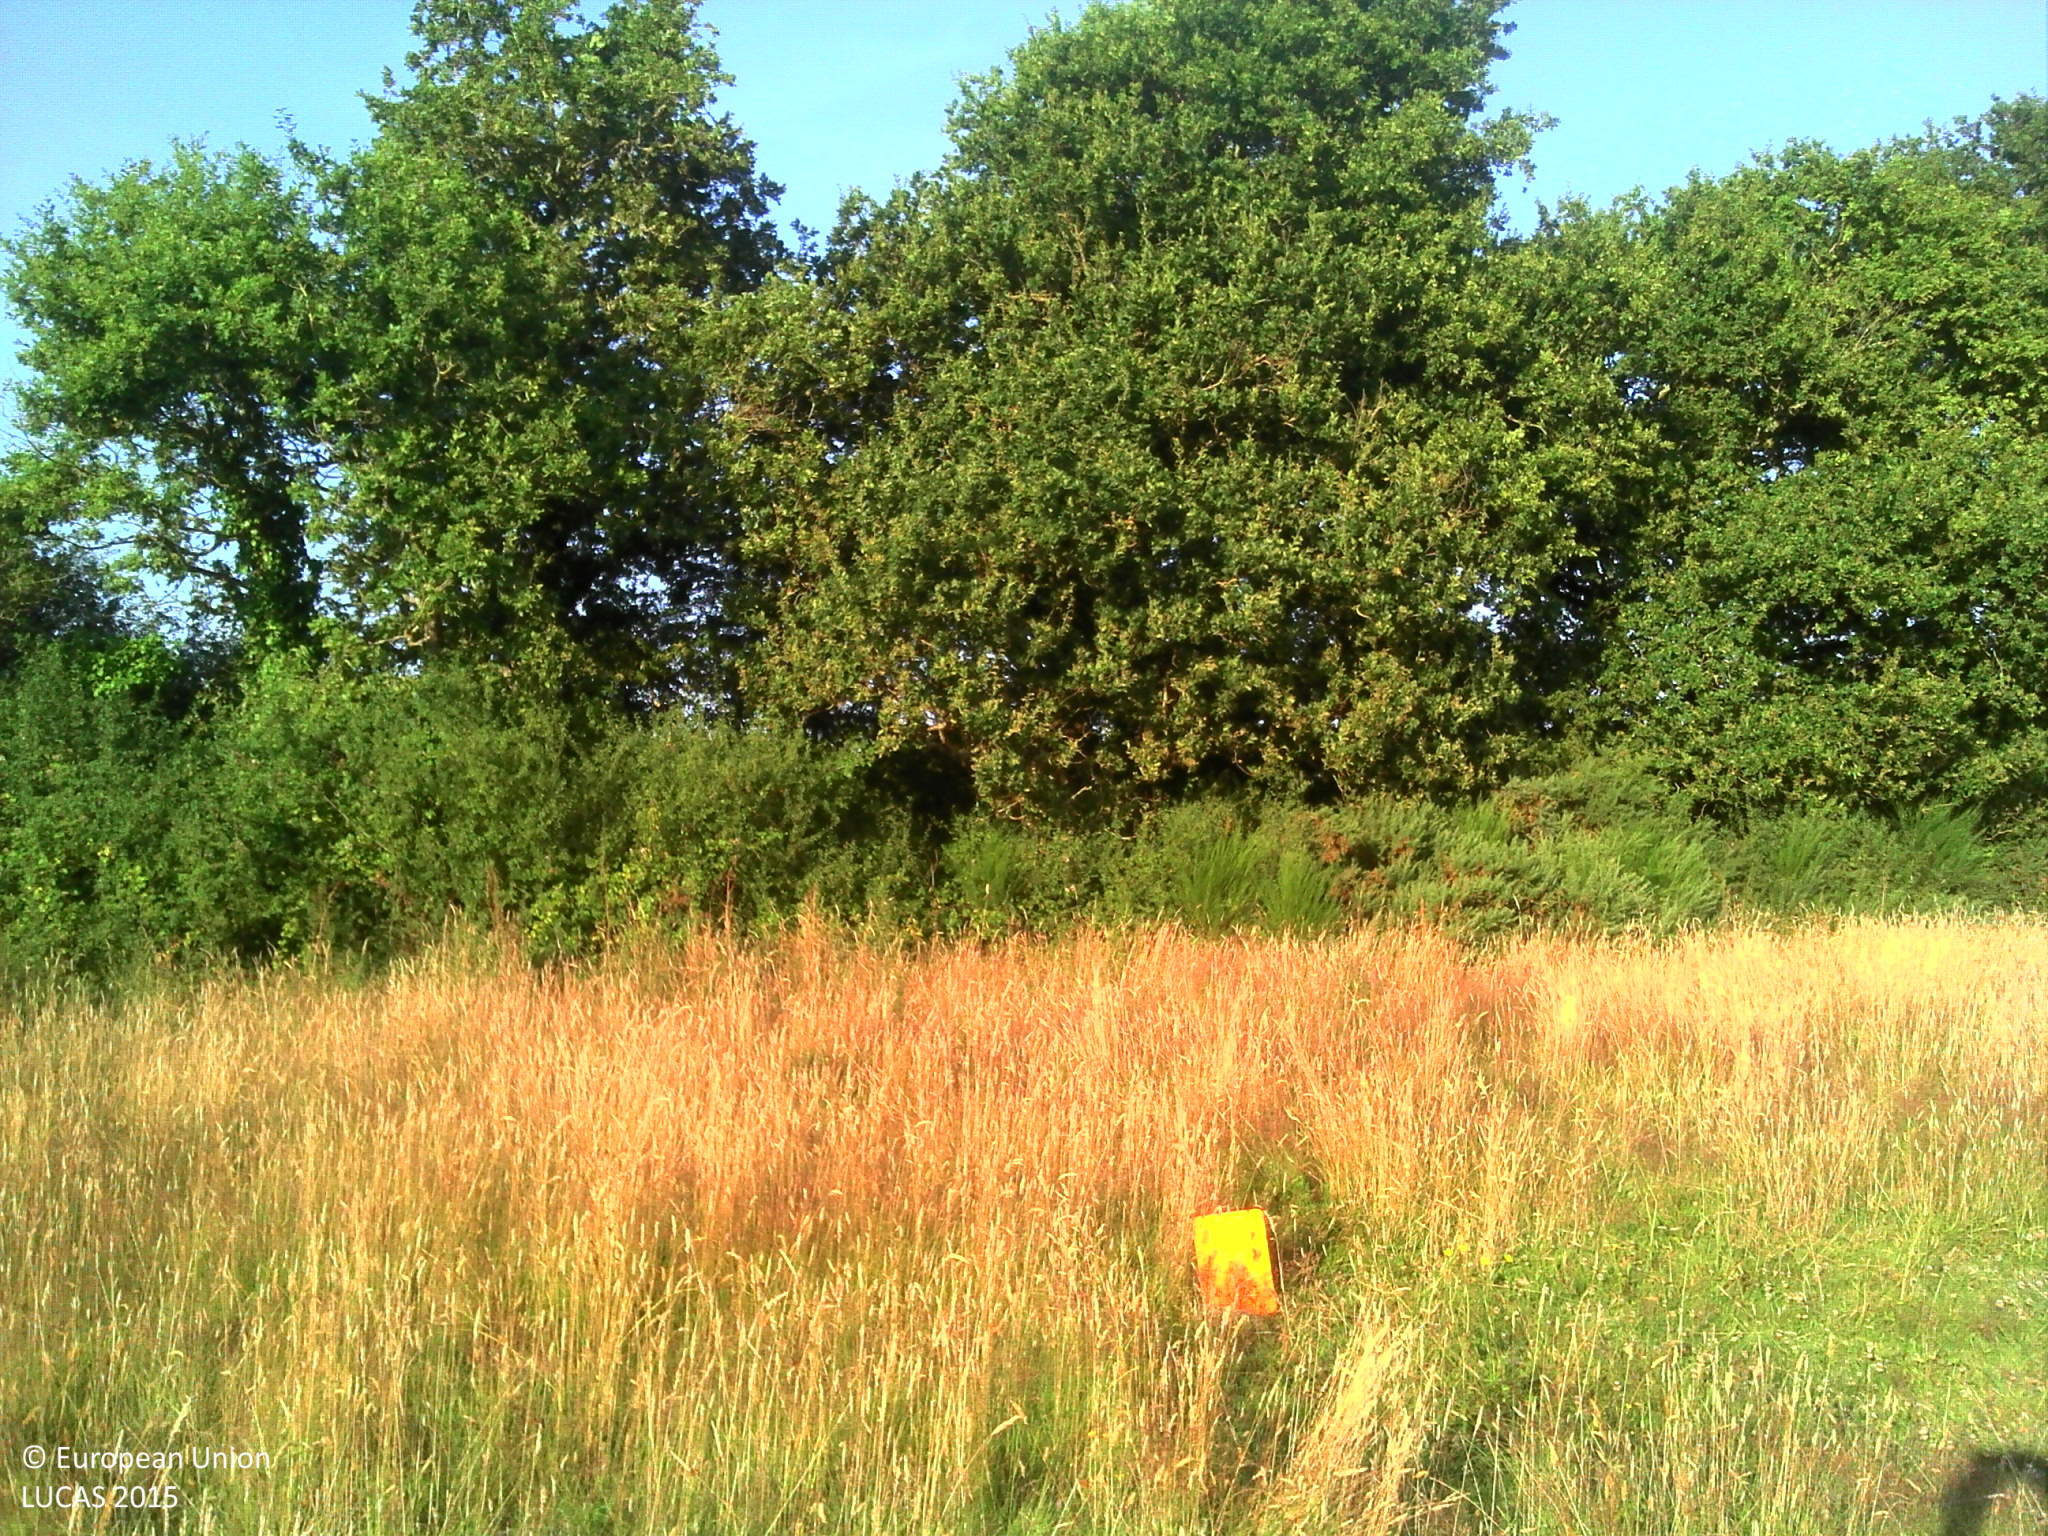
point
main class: Grassland
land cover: Grassland without tree/shrub cover
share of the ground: > 75 %
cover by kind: herbaceous plants 100 %
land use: Agriculture (excluding fallow land and kitchen gardens)
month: July
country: FR
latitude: 46.4674
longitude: -1.5633
